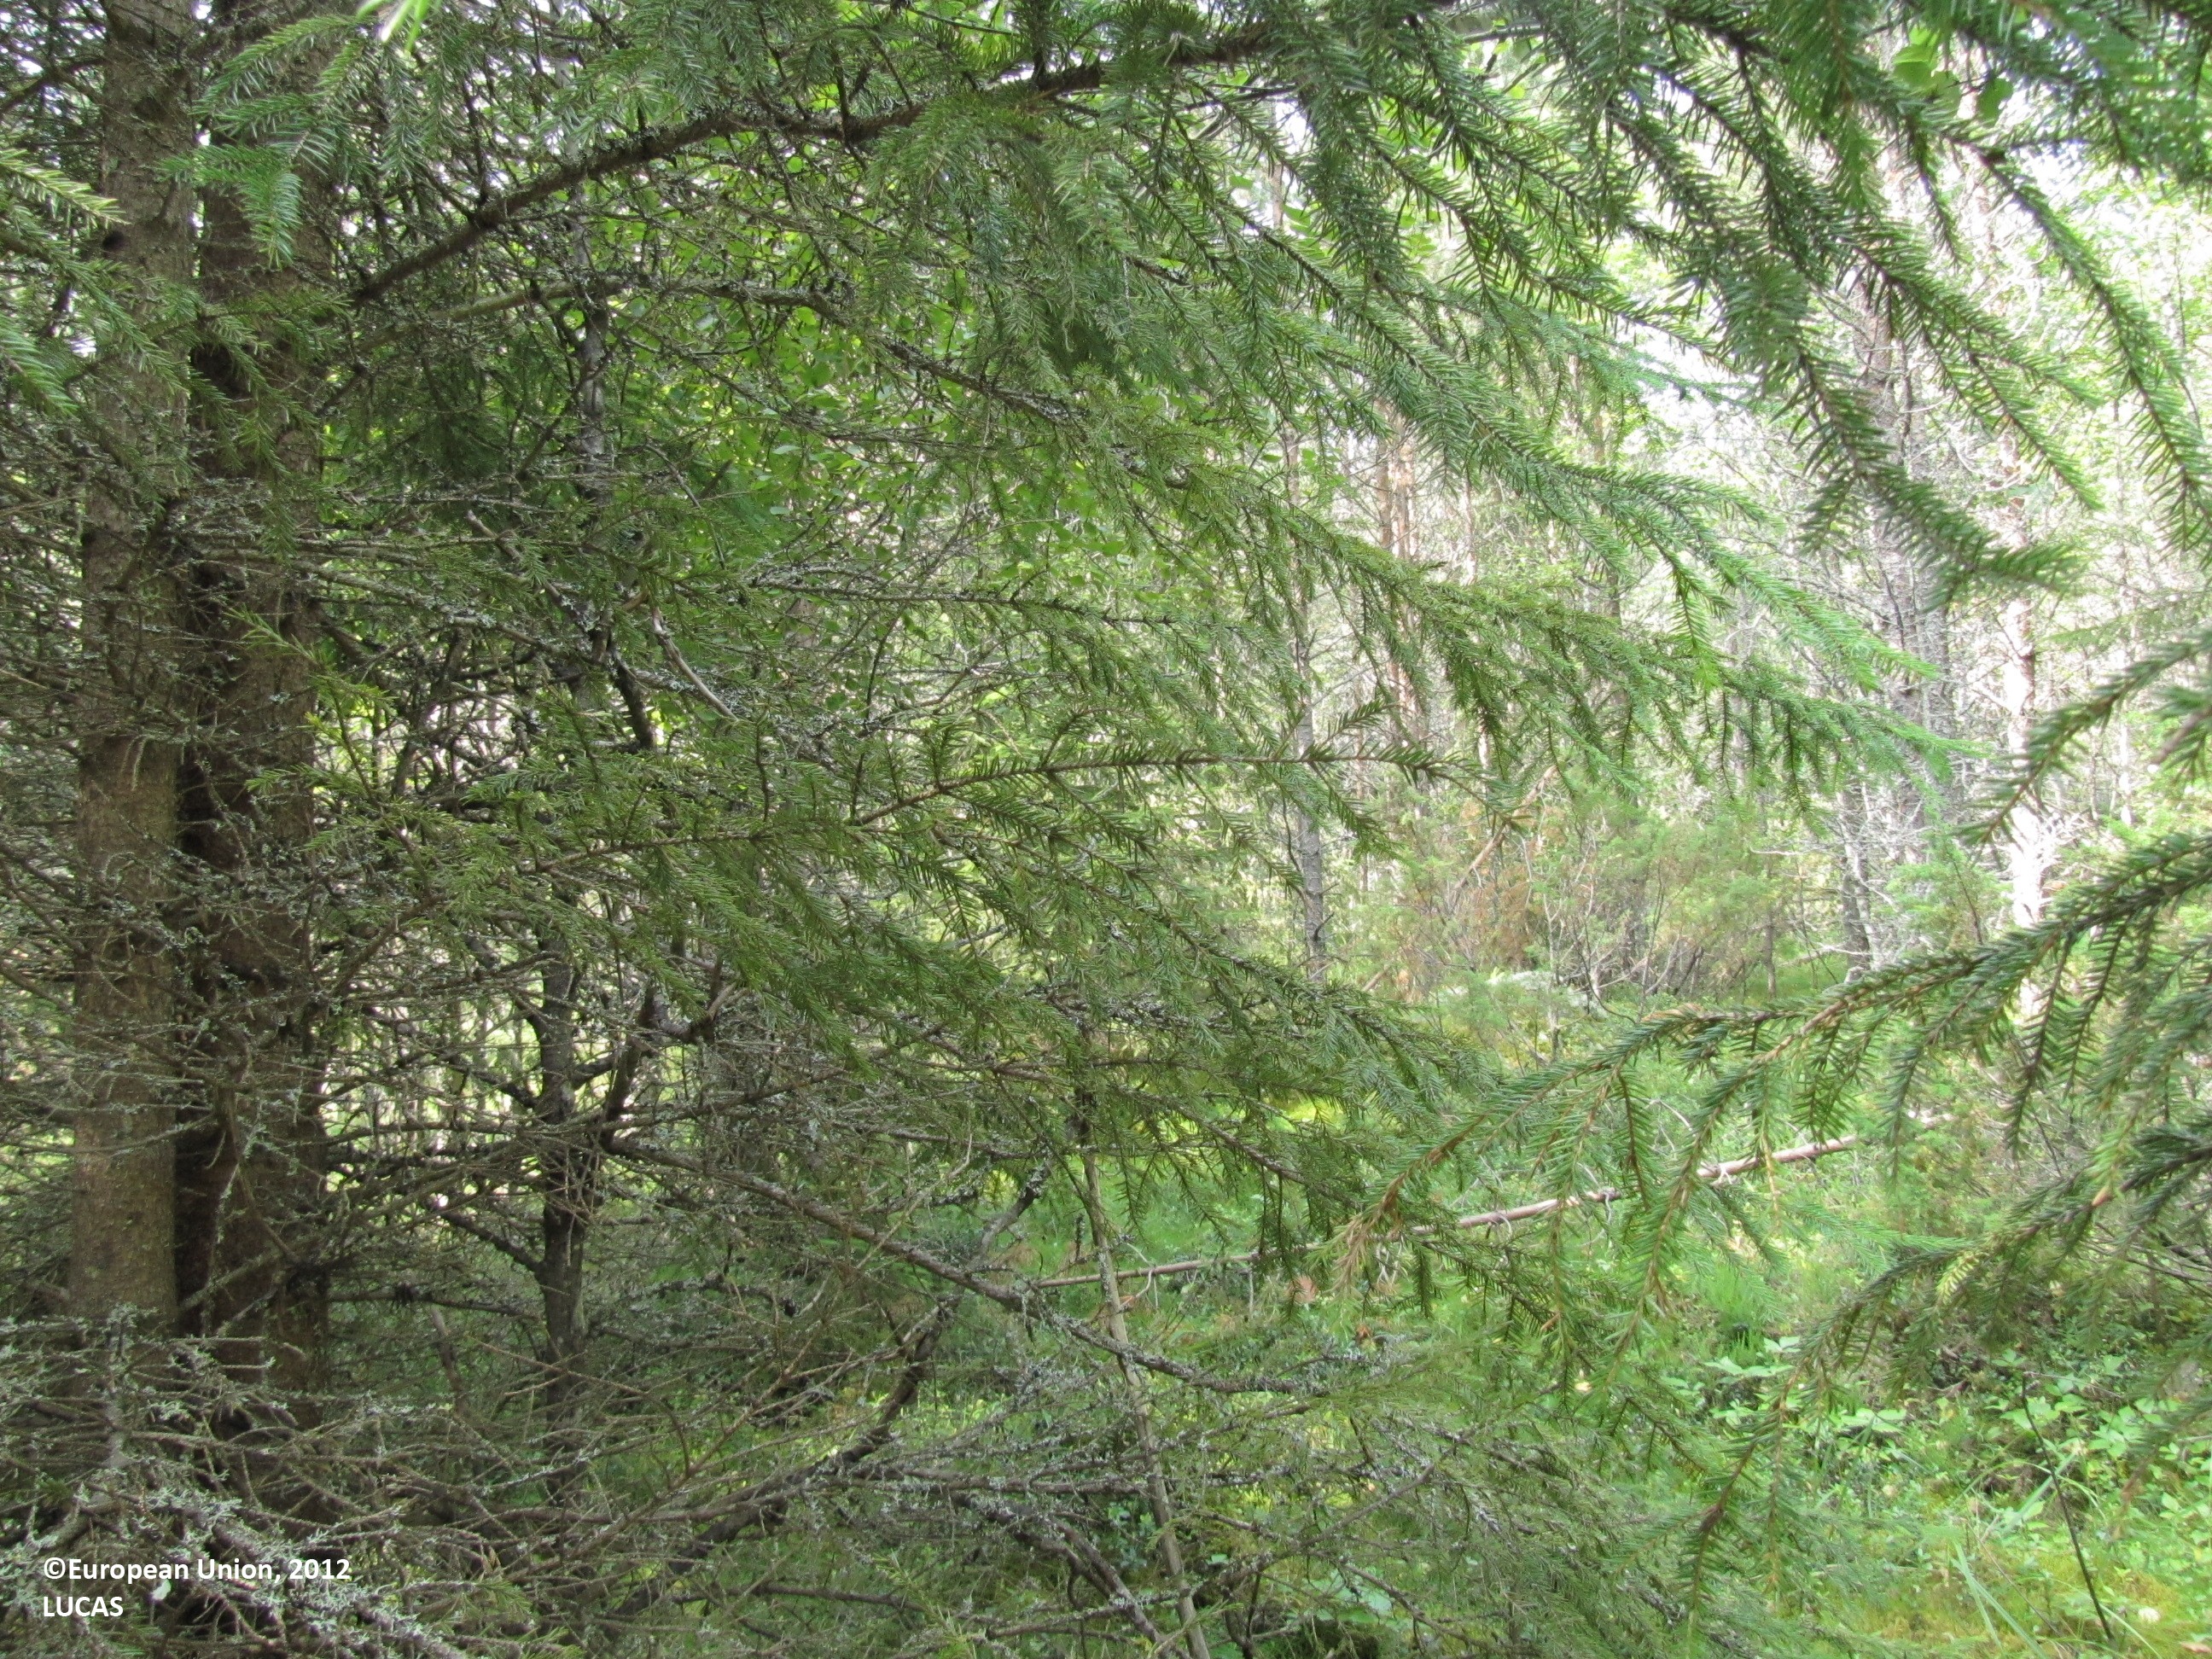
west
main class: Woodland
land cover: Spruce dominated mixed woodland
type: boreal forest
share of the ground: > 75 %
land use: Forestry
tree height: > 5 m
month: July
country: FI
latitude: 61.9650
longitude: 23.2889
